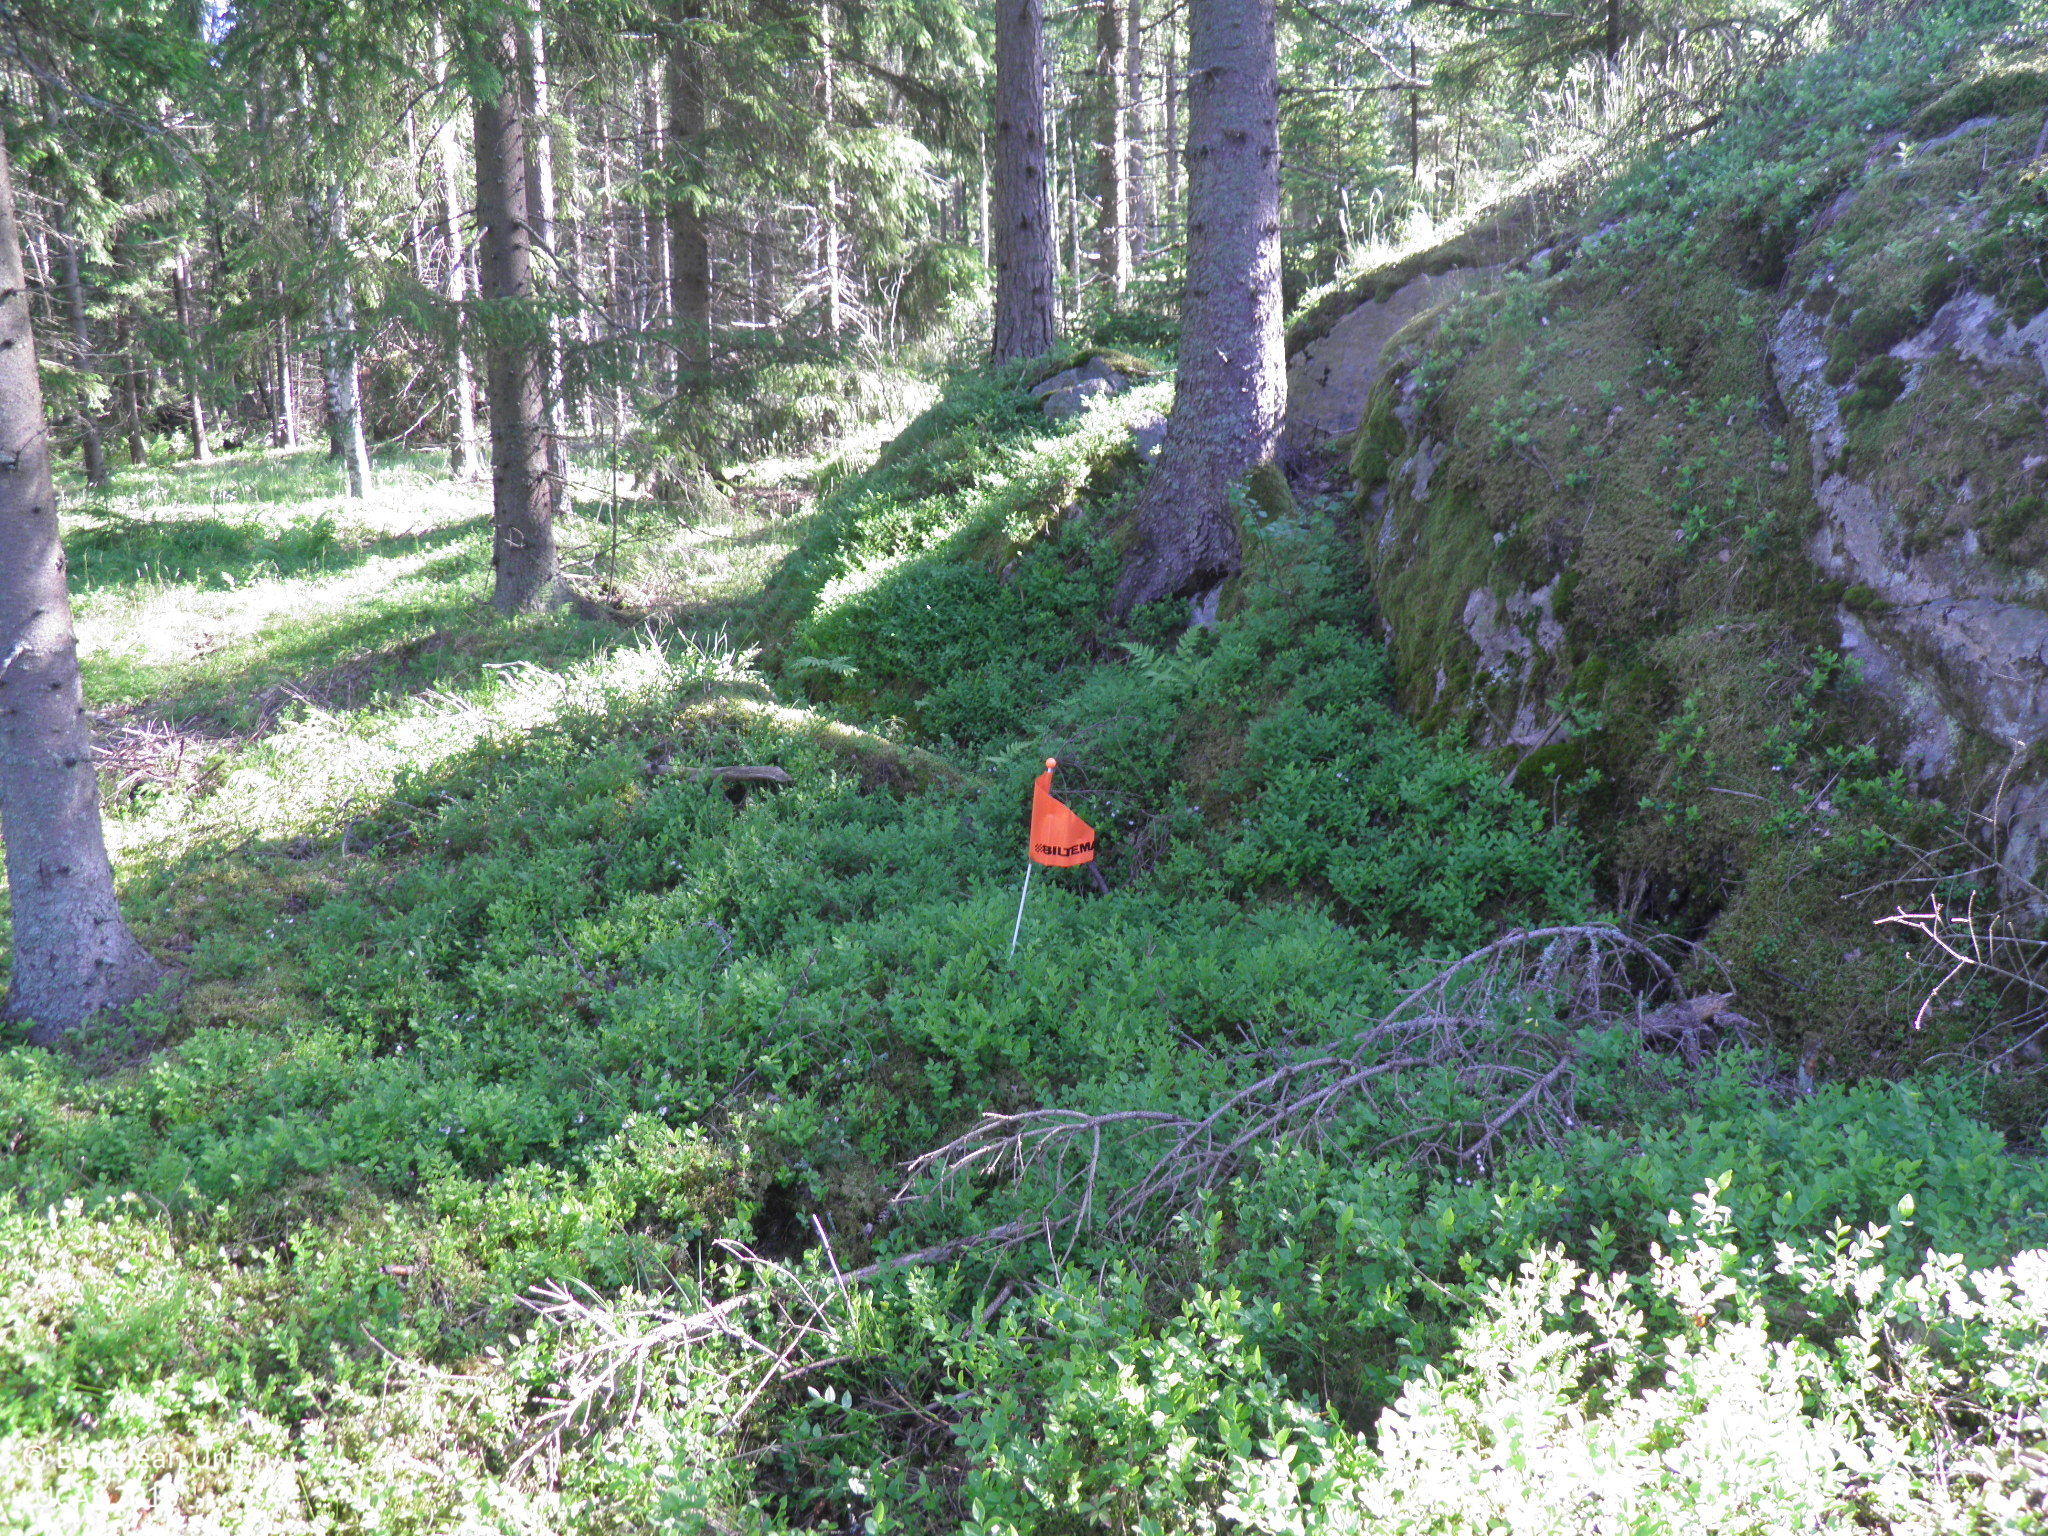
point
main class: Woodland
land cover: Other coniferous woodland
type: hemiboreal forest and nemoral coniferous forest and mixed broadleaved-coniferous forest
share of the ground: > 75 %
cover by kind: coniferous forest trees 70 %, shrubs 20 %, broadleaved forest trees 5 %, herbaceous plants 5 %
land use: Forestry
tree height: > 5 m
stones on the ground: < 10 %
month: June
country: FI
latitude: 60.3746
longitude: 22.8622
